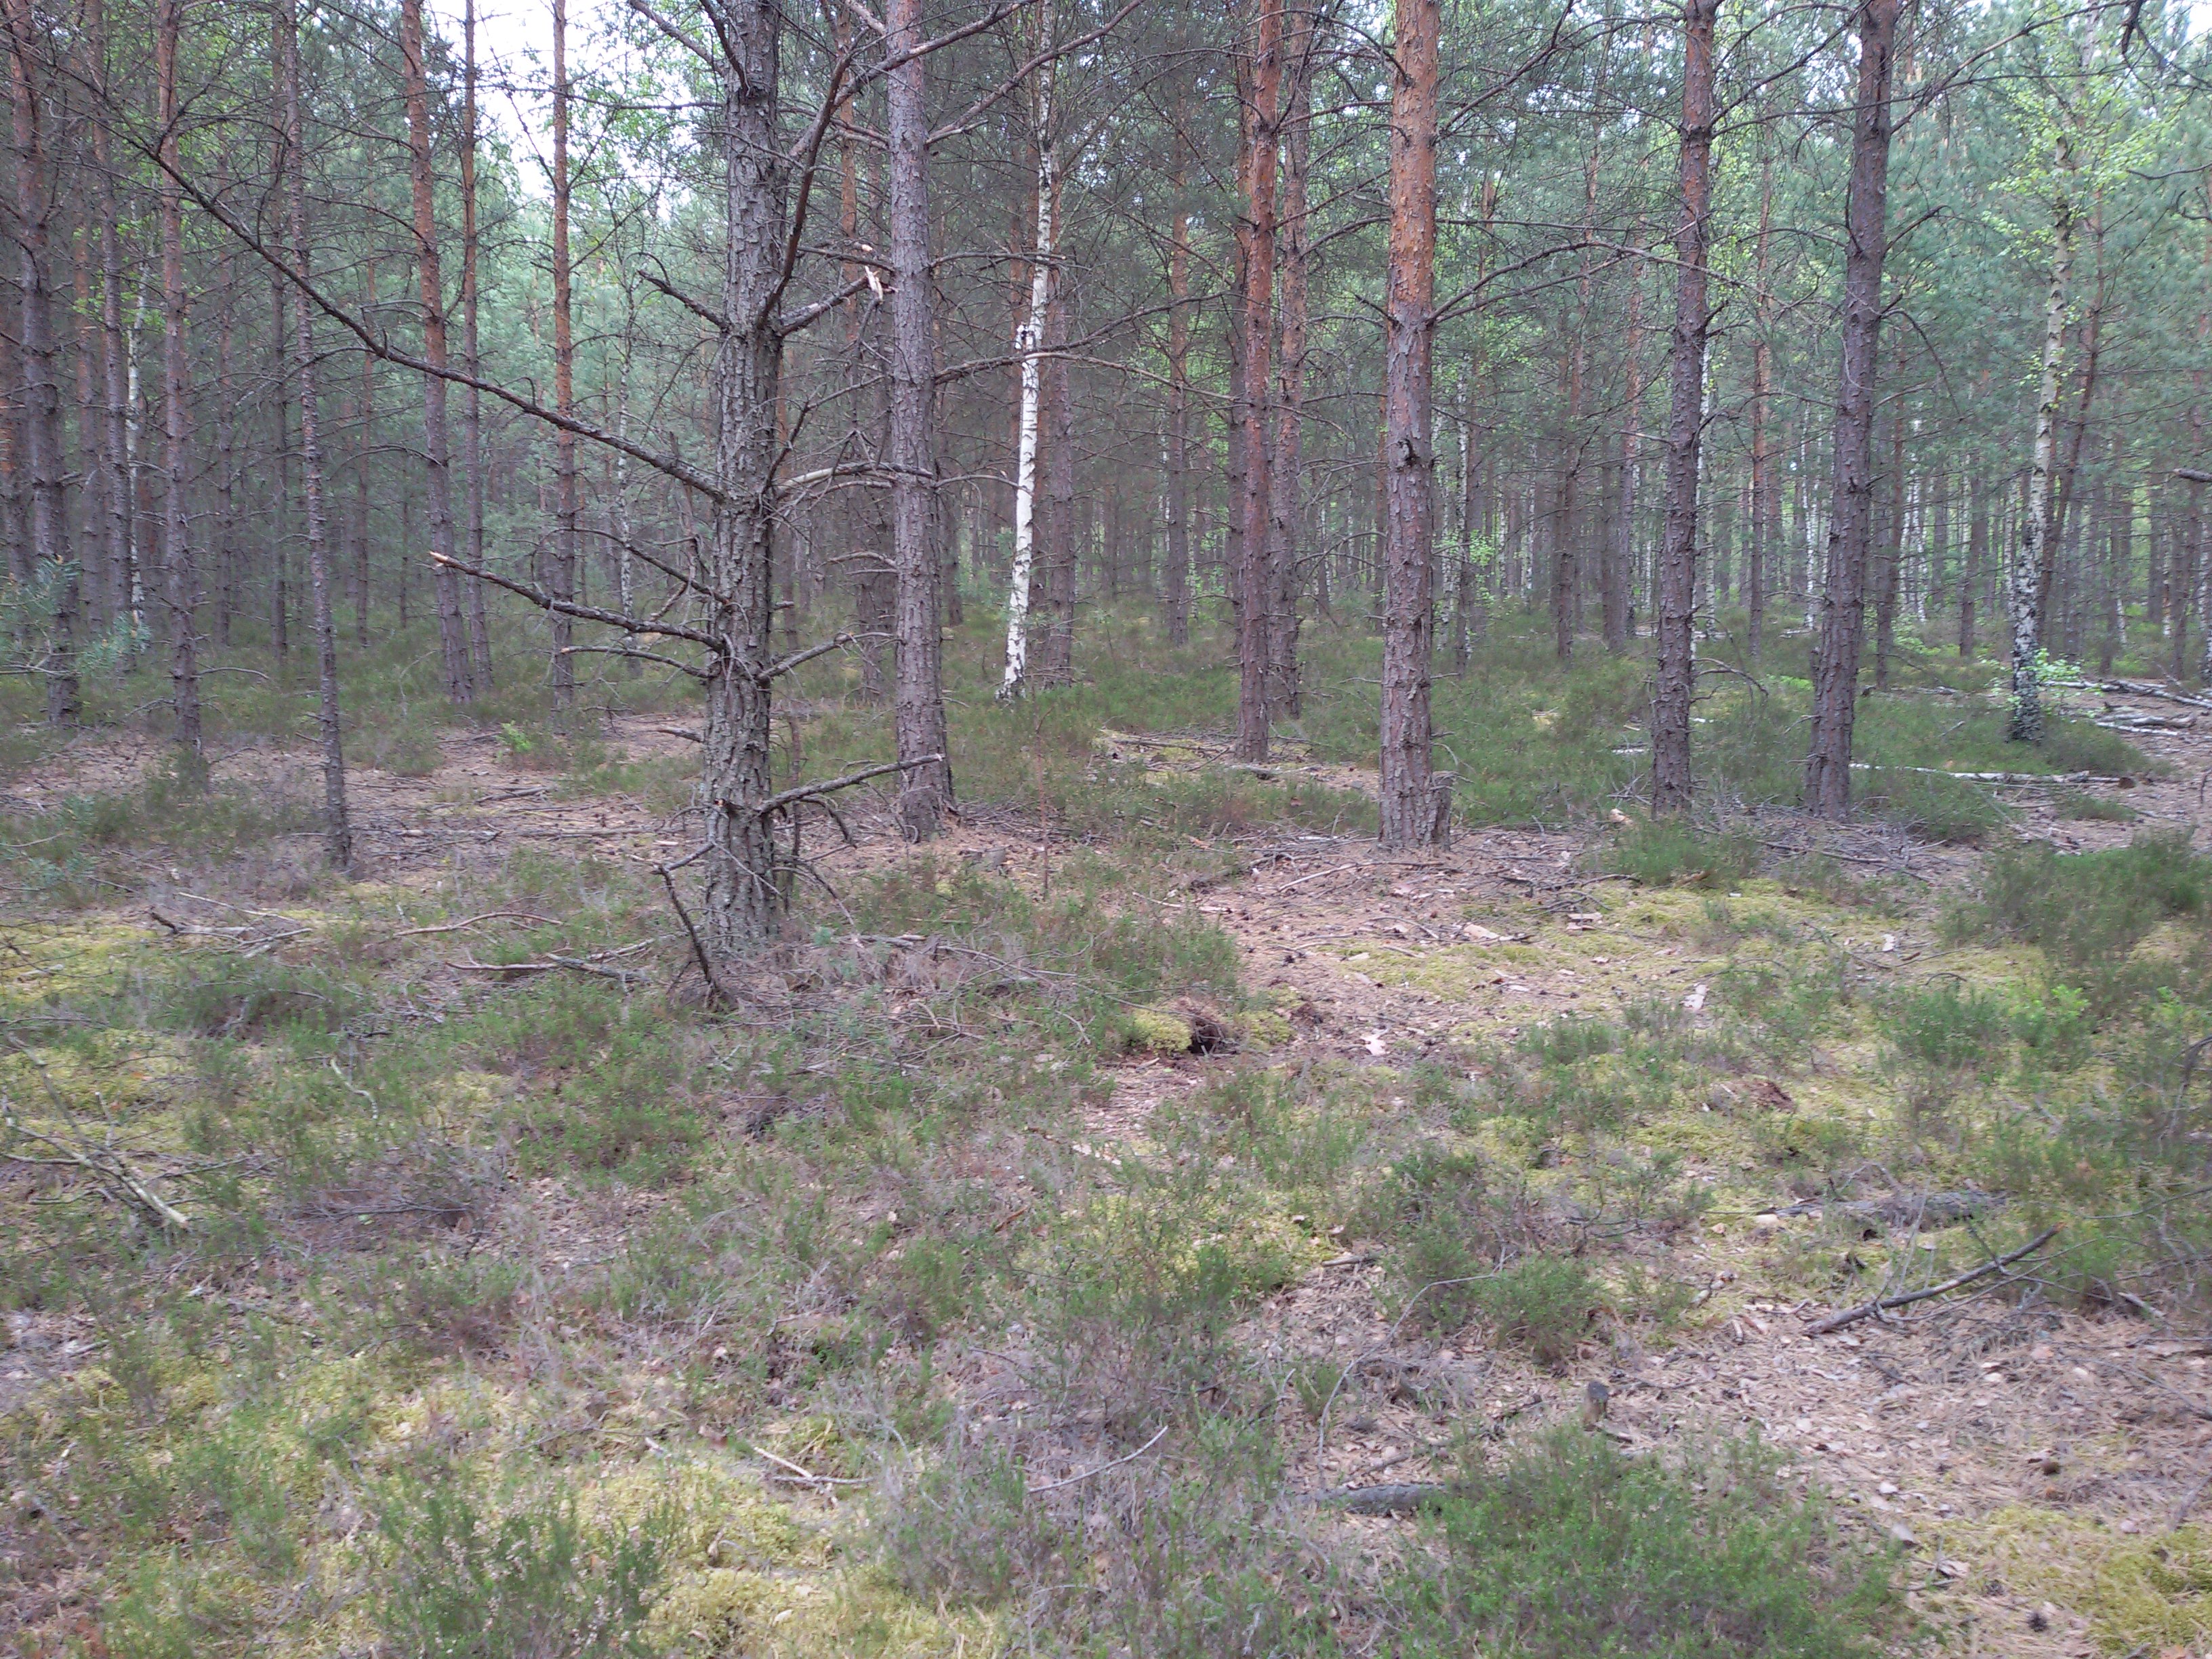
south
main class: Woodland
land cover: Pine dominated coniferous woodland
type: hemiboreal forest and nemoral coniferous forest and mixed broadleaved-coniferous forest
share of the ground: 50 - 75 %
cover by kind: coniferous forest trees 70 %, herbaceous plants 15 %, lichens and mosses 10 %, unconsolidated bare surface 5 %
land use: Forestry
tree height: > 5 m
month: May
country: PL
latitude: 51.4454
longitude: 15.7459
